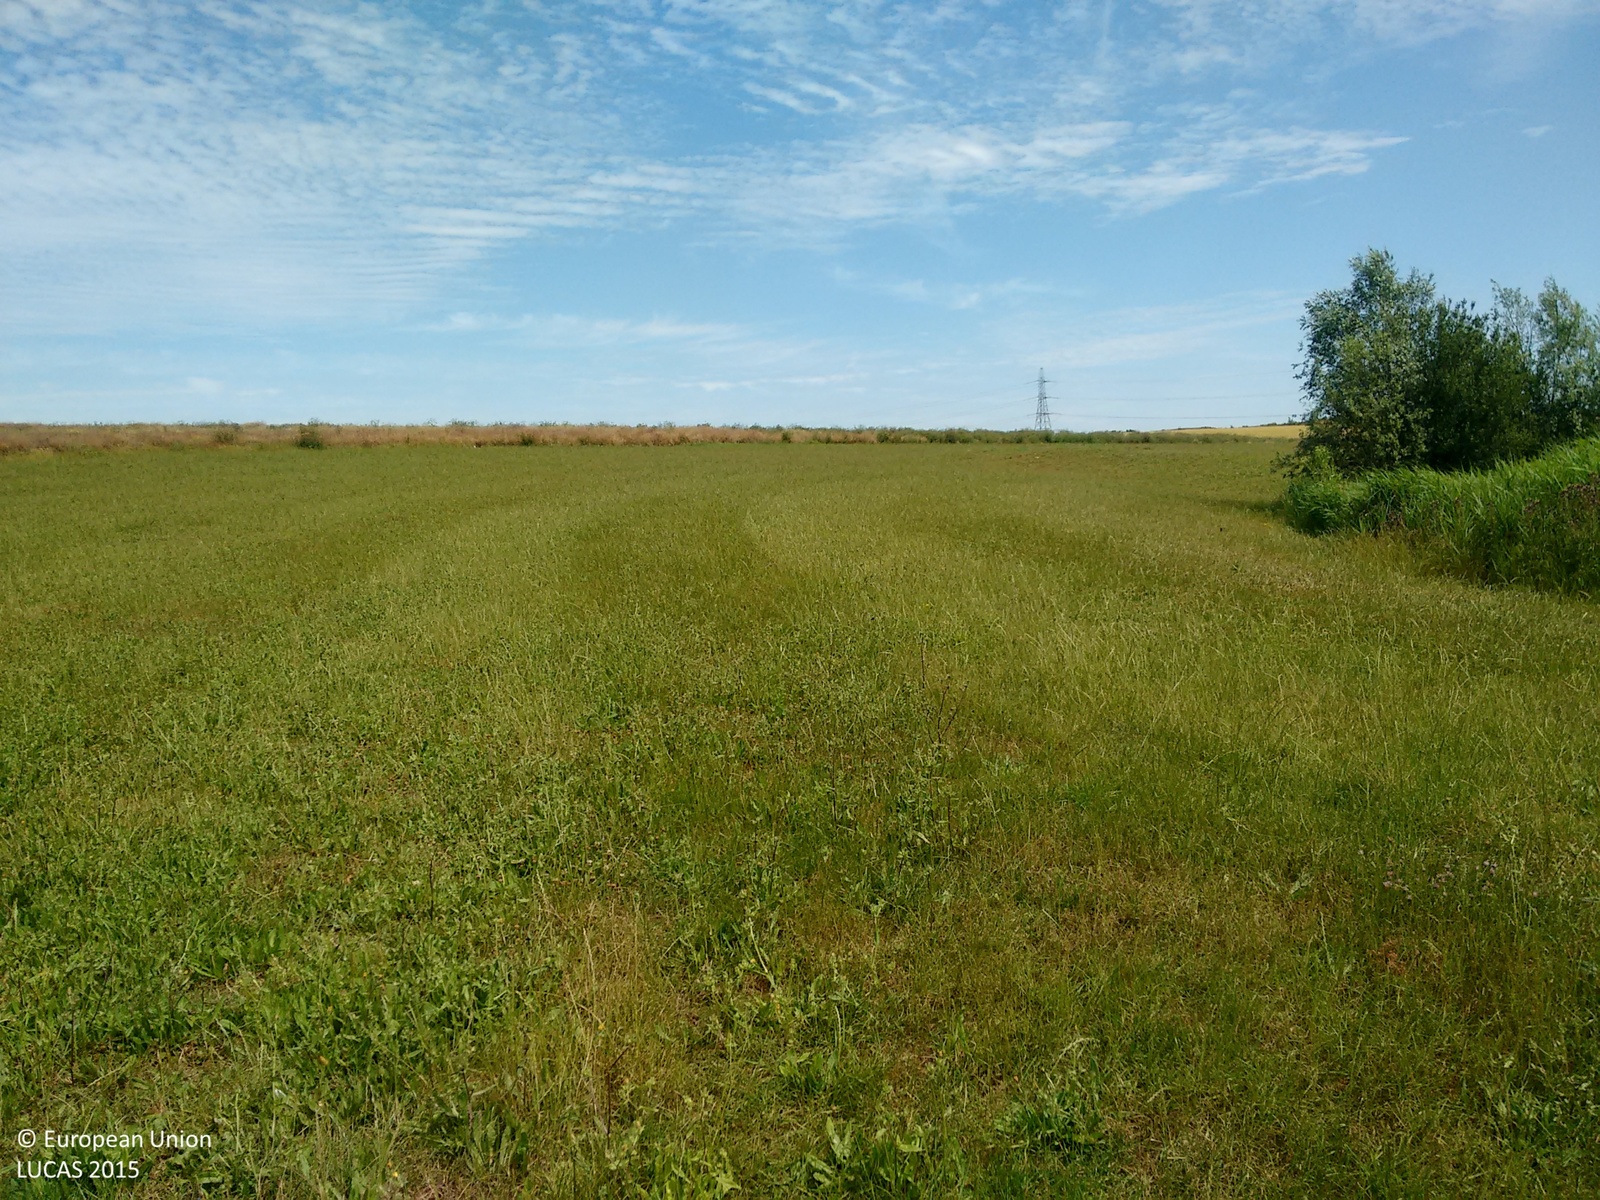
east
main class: Grassland
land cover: Grassland without tree/shrub cover
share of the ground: > 75 %
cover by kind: herbaceous plants 100 %
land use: Sport
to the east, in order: Grassland without tree/shrub cover; Spontaneously vegetated surfaces; Grass margins; Ditches and canals; Grass margins; Common wheat
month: July
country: GB
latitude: 51.5832
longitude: 0.5486
